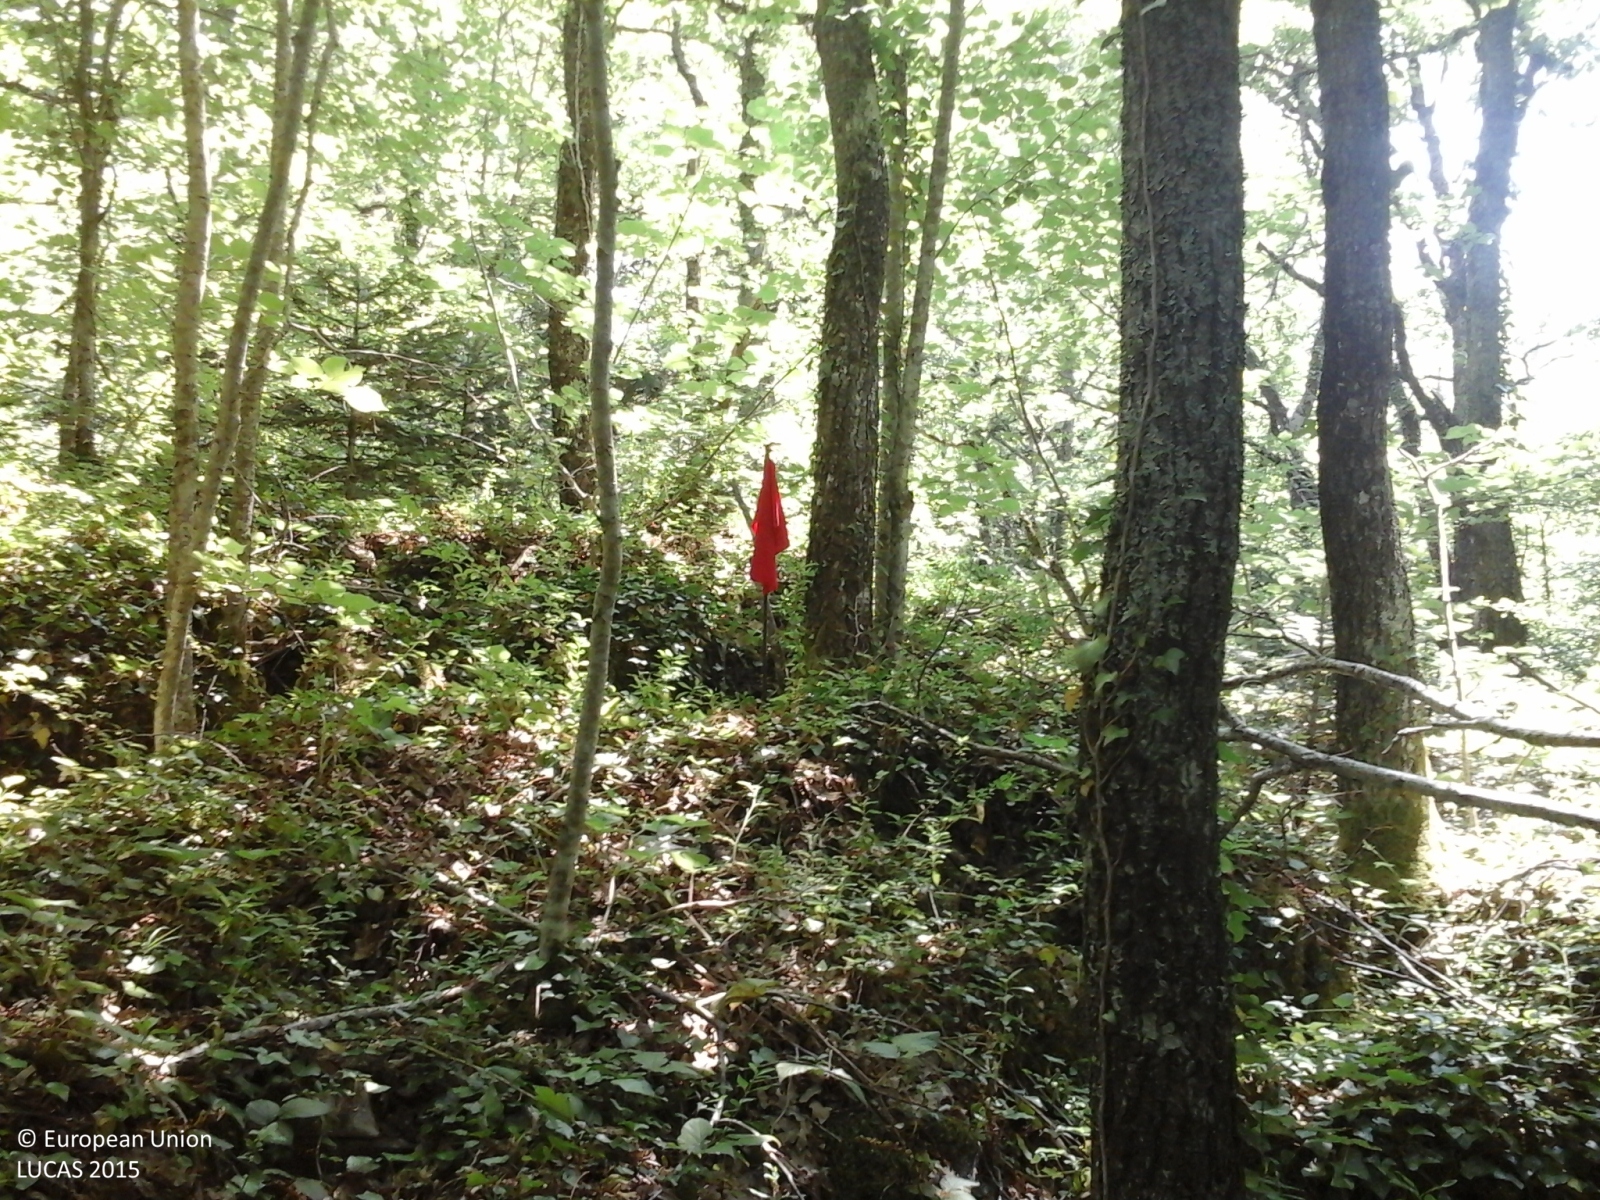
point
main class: Woodland
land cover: Other mixed woodland
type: hemiboreal forest and nemoral coniferous forest and mixed broadleaved-coniferous forest
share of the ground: > 75 %
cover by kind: coniferous forest trees 40 %, broadleaved forest trees 40 %, shrubs 10 %, herbaceous plants 5 %, lichens and mosses 5 %
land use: Forestry
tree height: > 5 m
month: June
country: IT
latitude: 41.8929
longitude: 14.3125
